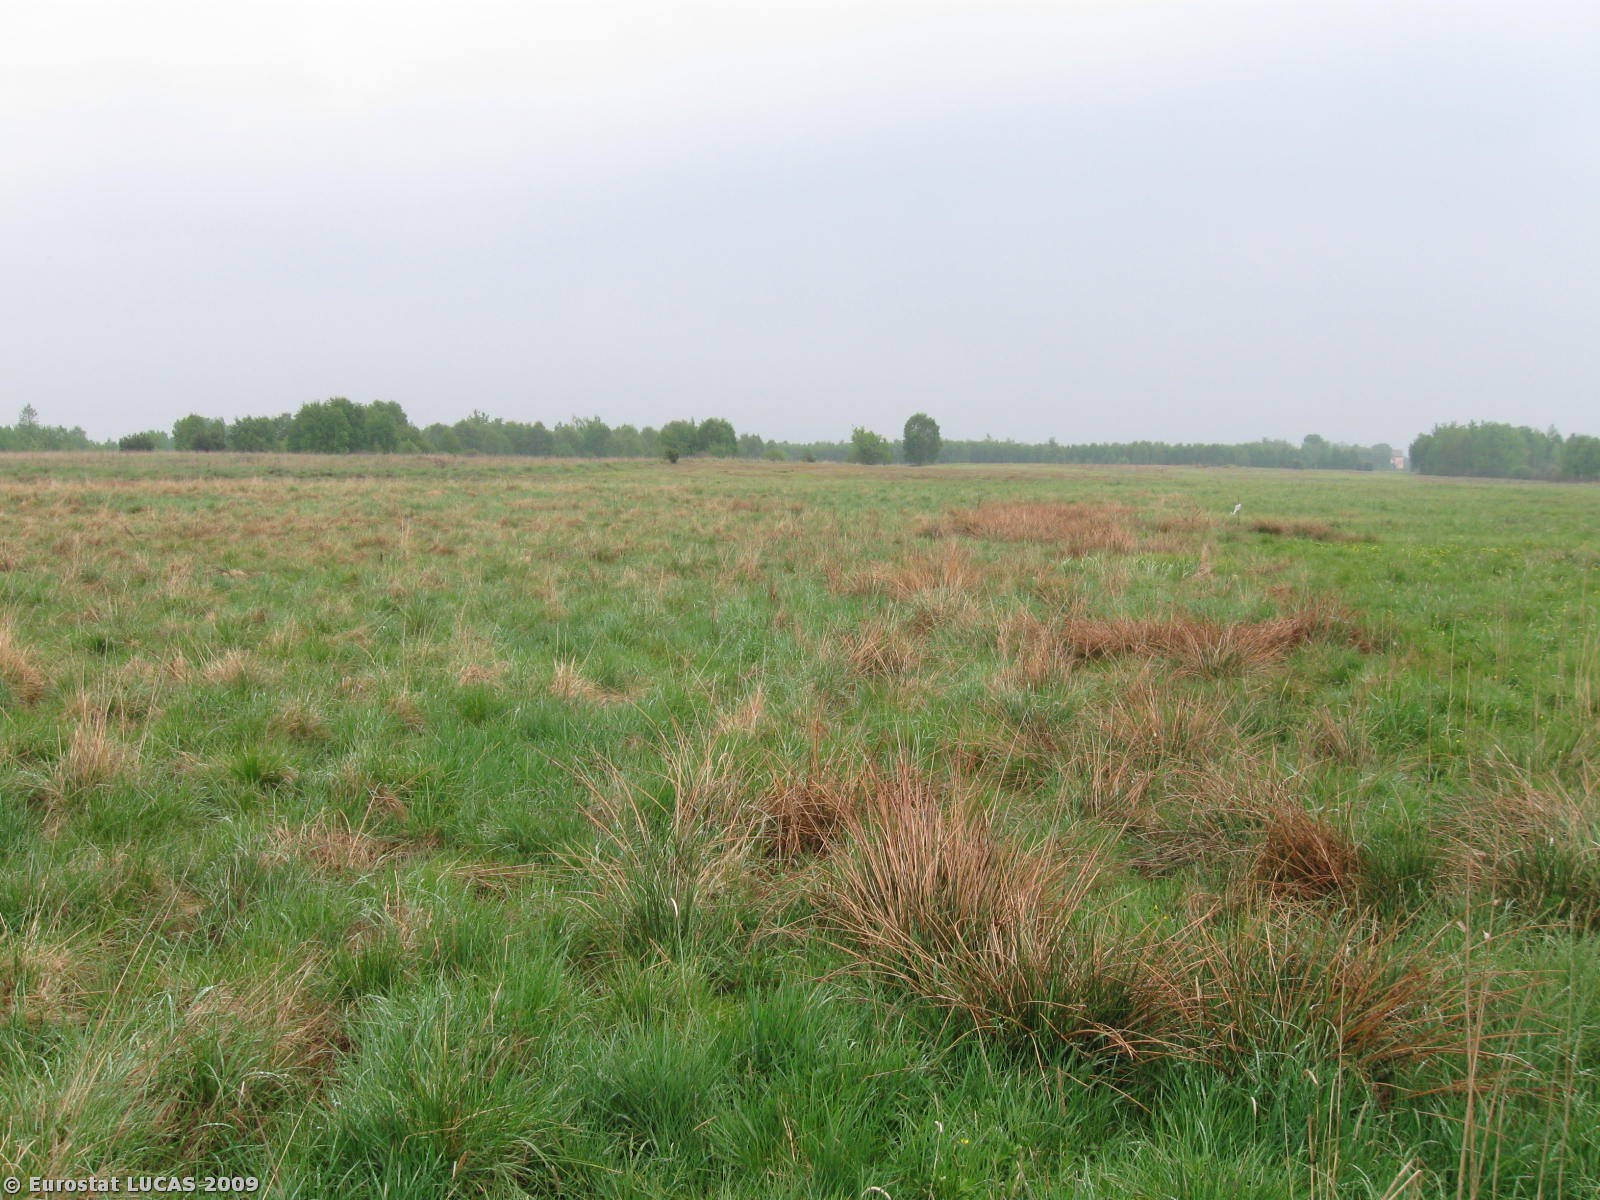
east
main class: Grassland
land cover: Grassland without tree/shrub cover
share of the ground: > 75 %
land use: Unused
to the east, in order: Grassland without tree/shrub cover
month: May
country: PL
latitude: 51.0459
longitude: 20.4359
